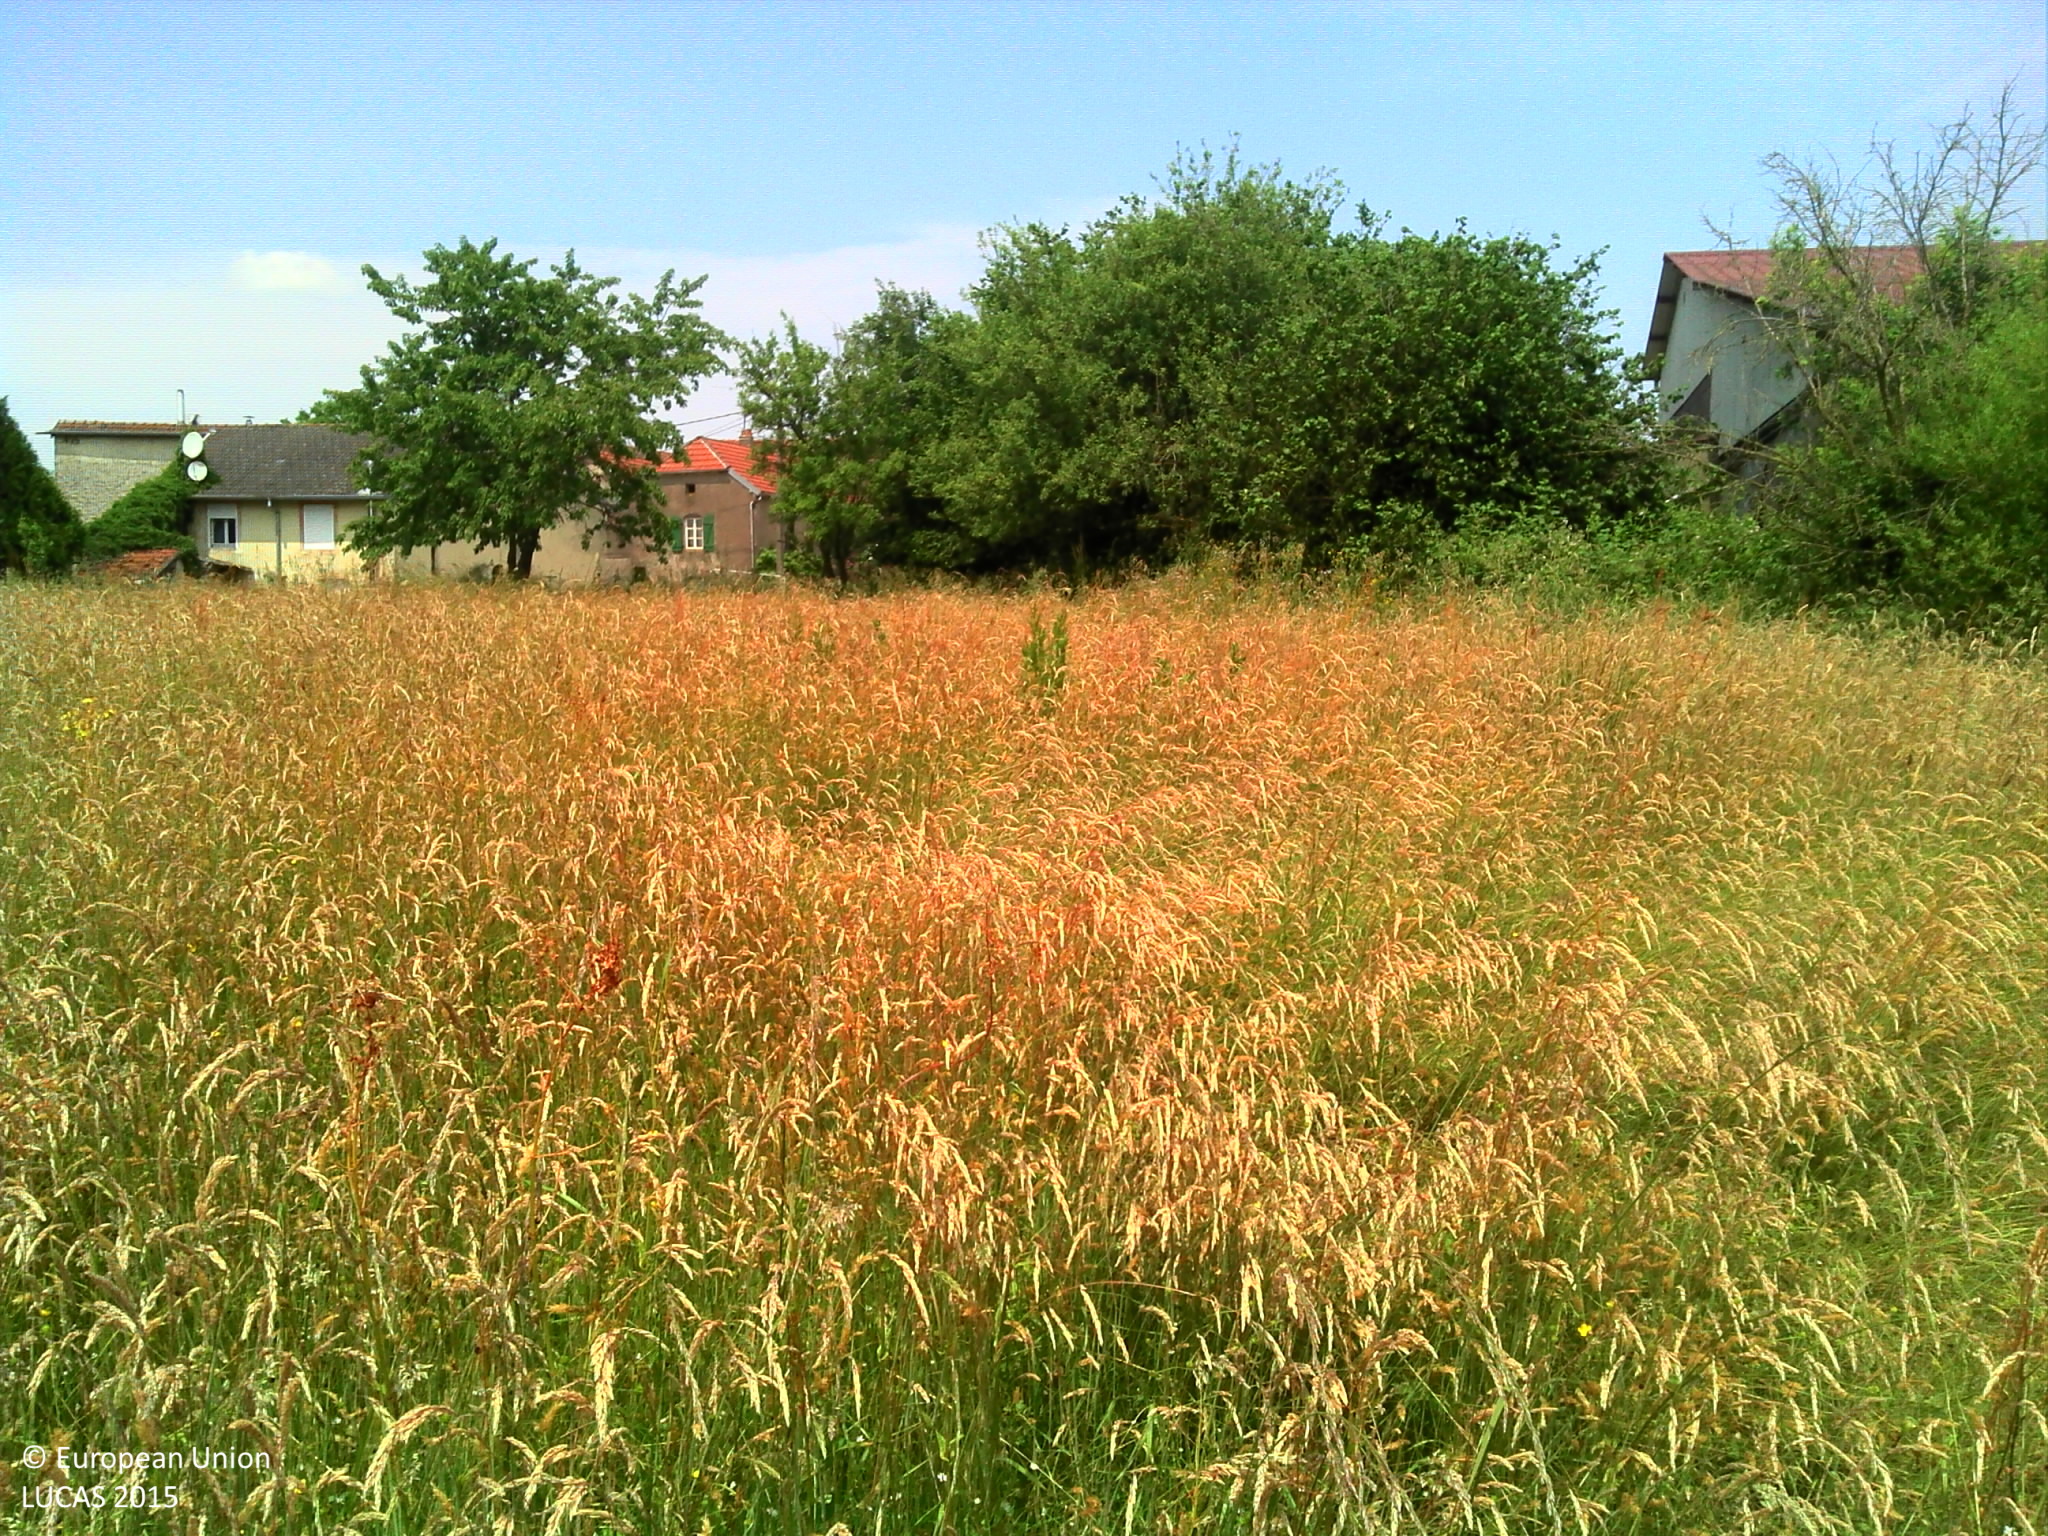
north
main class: Grassland
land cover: Grassland without tree/shrub cover
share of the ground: > 75 %
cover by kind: herbaceous plants 100 %
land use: Agriculture (excluding fallow land and kitchen gardens)
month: June
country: FR
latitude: 47.8525
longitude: 6.2188
